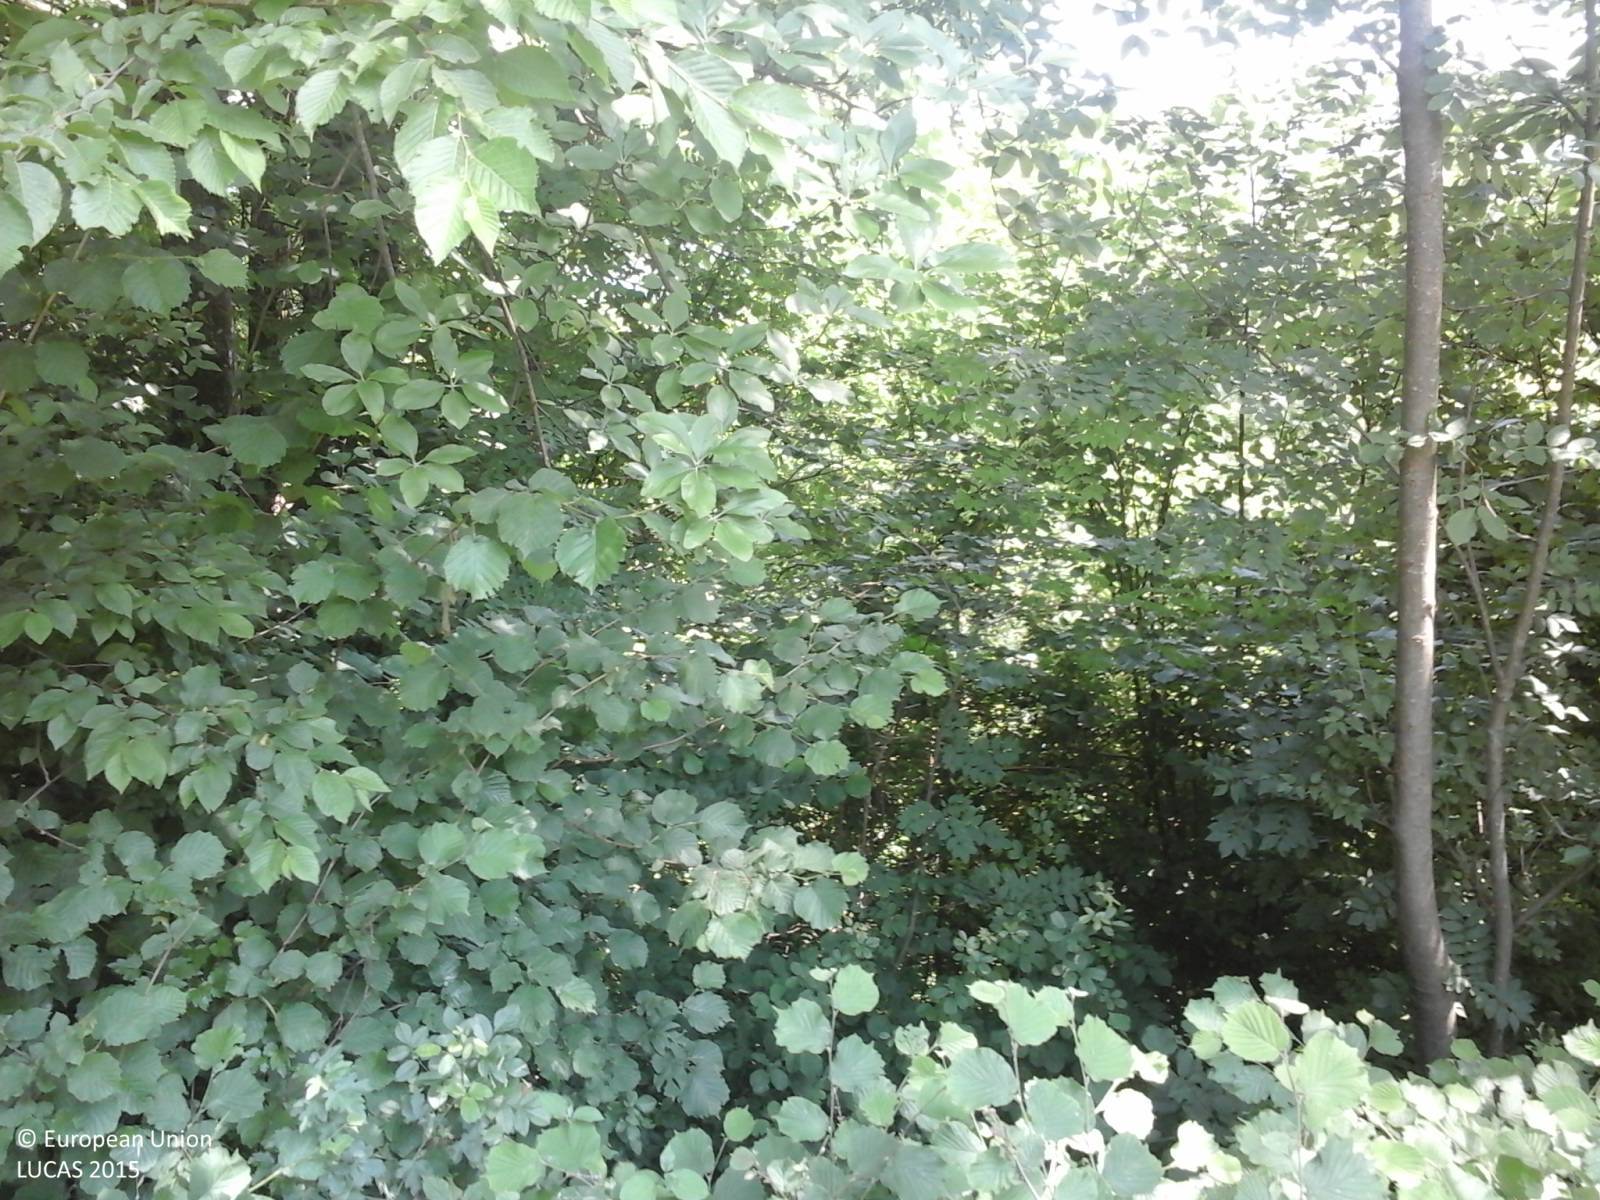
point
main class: Woodland
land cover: Broadleaved woodland
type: thermophilous deciduous forest
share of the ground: > 75 %
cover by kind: broadleaved forest trees 90 %, shrubs 10 %
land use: Forestry
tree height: > 5 m
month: June
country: IT
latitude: 46.2262
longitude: 12.7326
